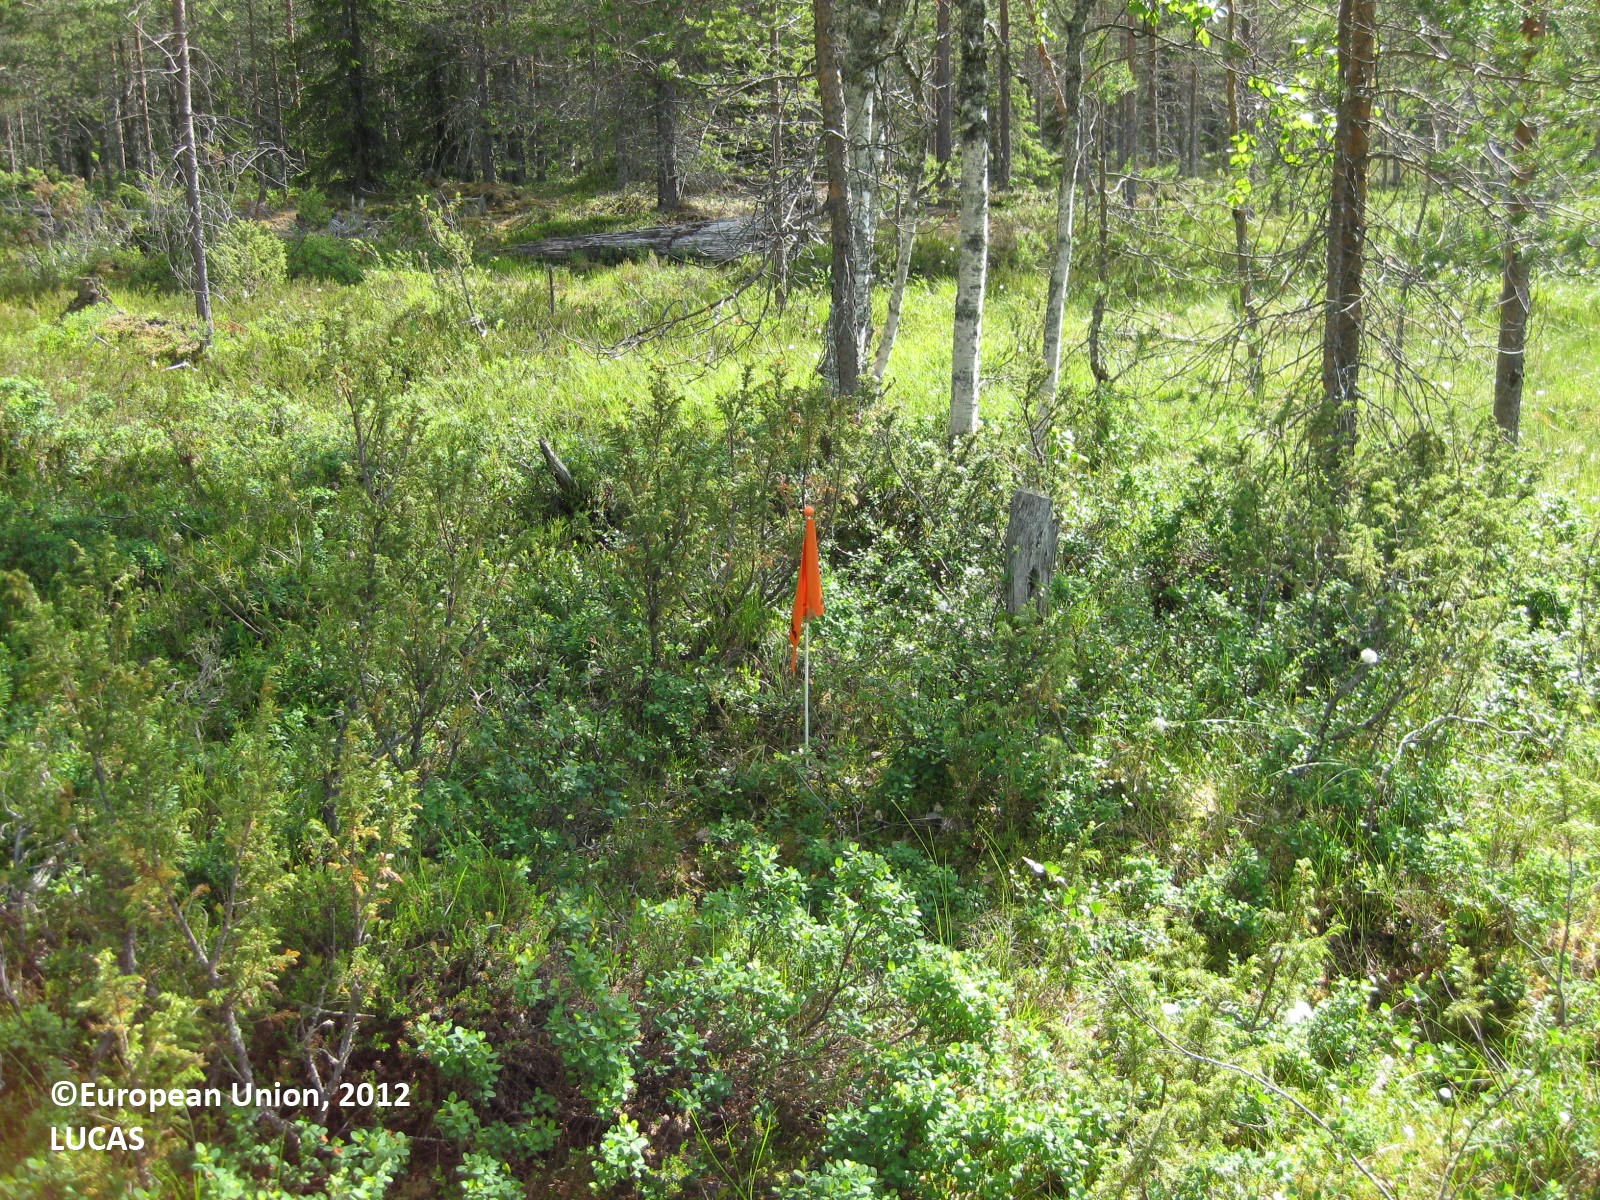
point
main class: Woodland
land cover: Pine dominated coniferous woodland
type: boreal forest
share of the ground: 50 - 75 %
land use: Forestry
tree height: > 5 m
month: July
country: FI
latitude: 65.5223
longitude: 29.4238
